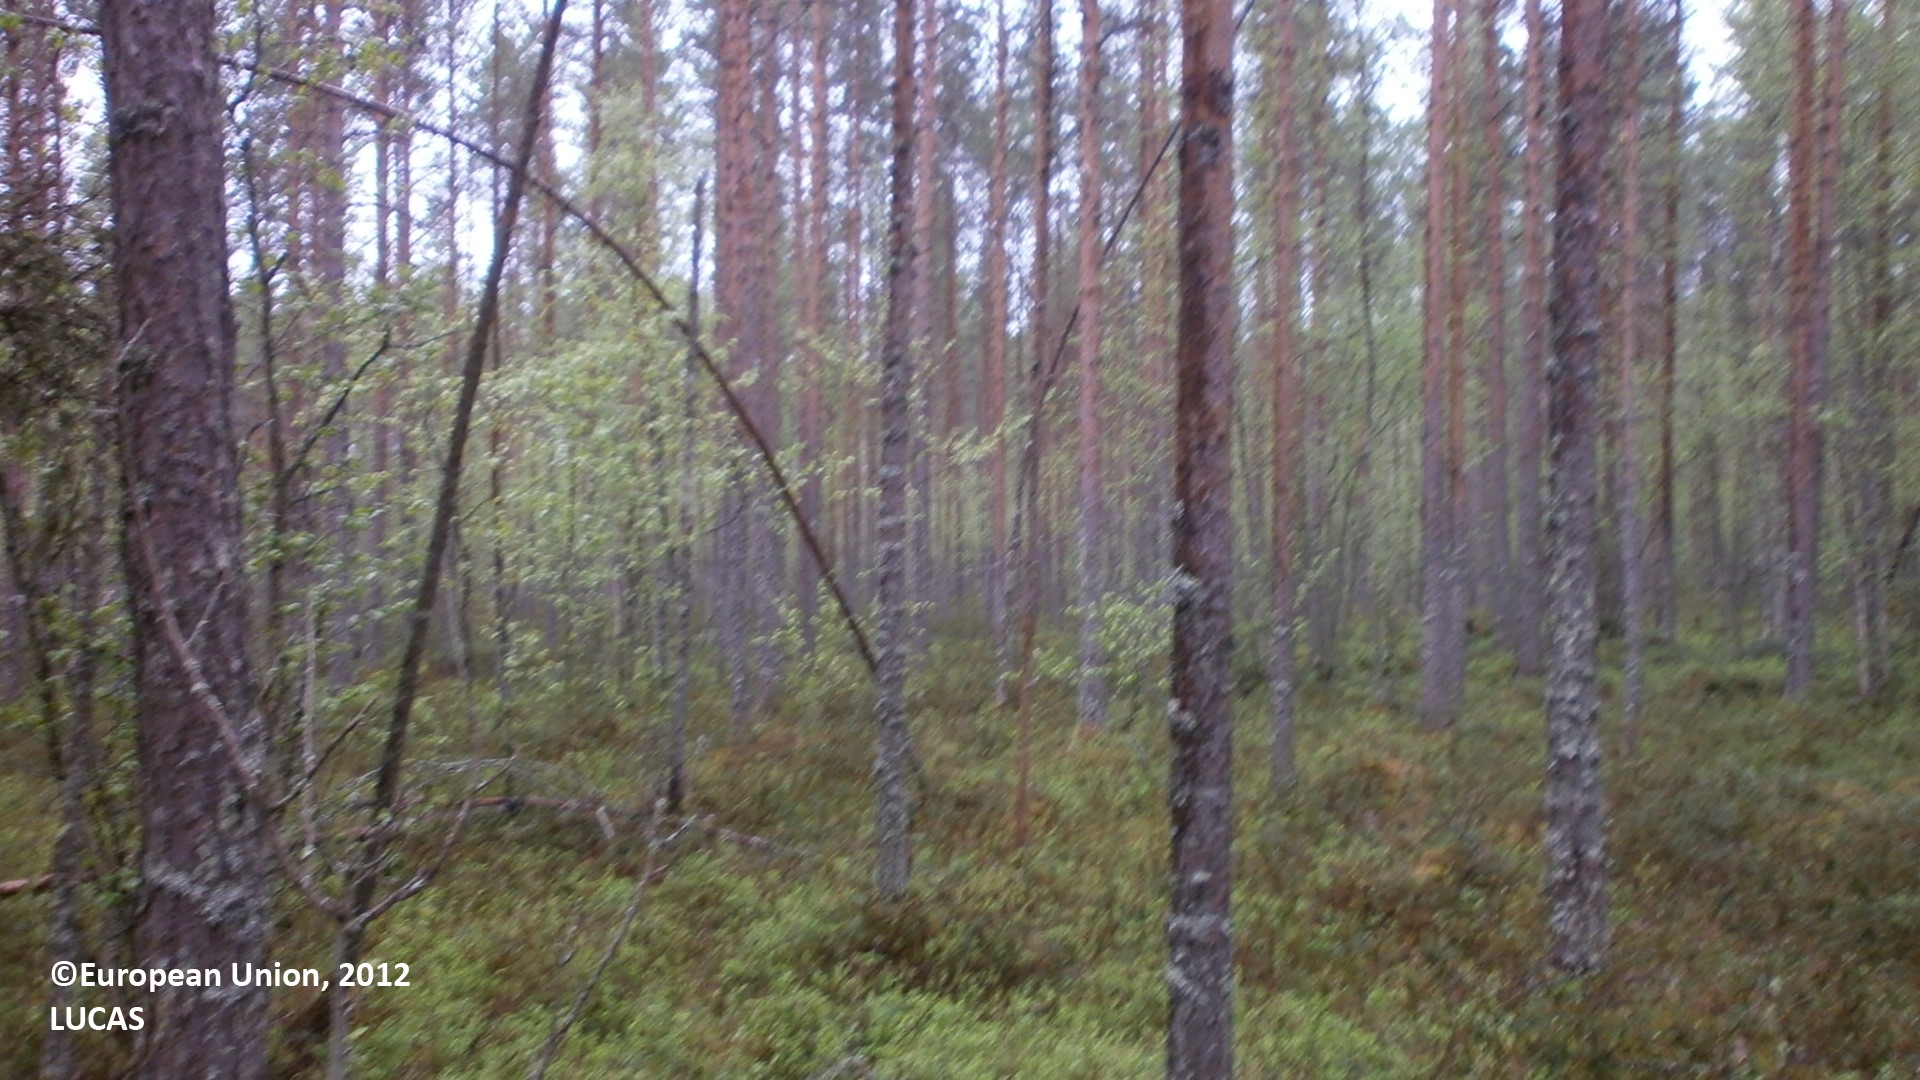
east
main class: Woodland
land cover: Pine dominated coniferous woodland
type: mire and swamp forests
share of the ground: 50 - 75 %
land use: Forestry
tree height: > 5 m
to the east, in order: Pine dominated coniferous woodland; Pine dominated mixed woodland; Ditches and canals; Pine dominated mixed woodland; Shrubland with sparse tree cover; Ditches and canals; Pine dominated coniferous woodland; Ditches and canals; Pine dominated coniferous woodland; Ditches and canals; Pine dominated coniferous woodland; Other mixed woodland; Ditches and canals; Pine dominated coniferous woodland; Ditches and canals; Pine dominated coniferous woodland; Ditches and canals; Pine dominated coniferous woodland
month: June
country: FI
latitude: 64.1227
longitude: 26.1065
